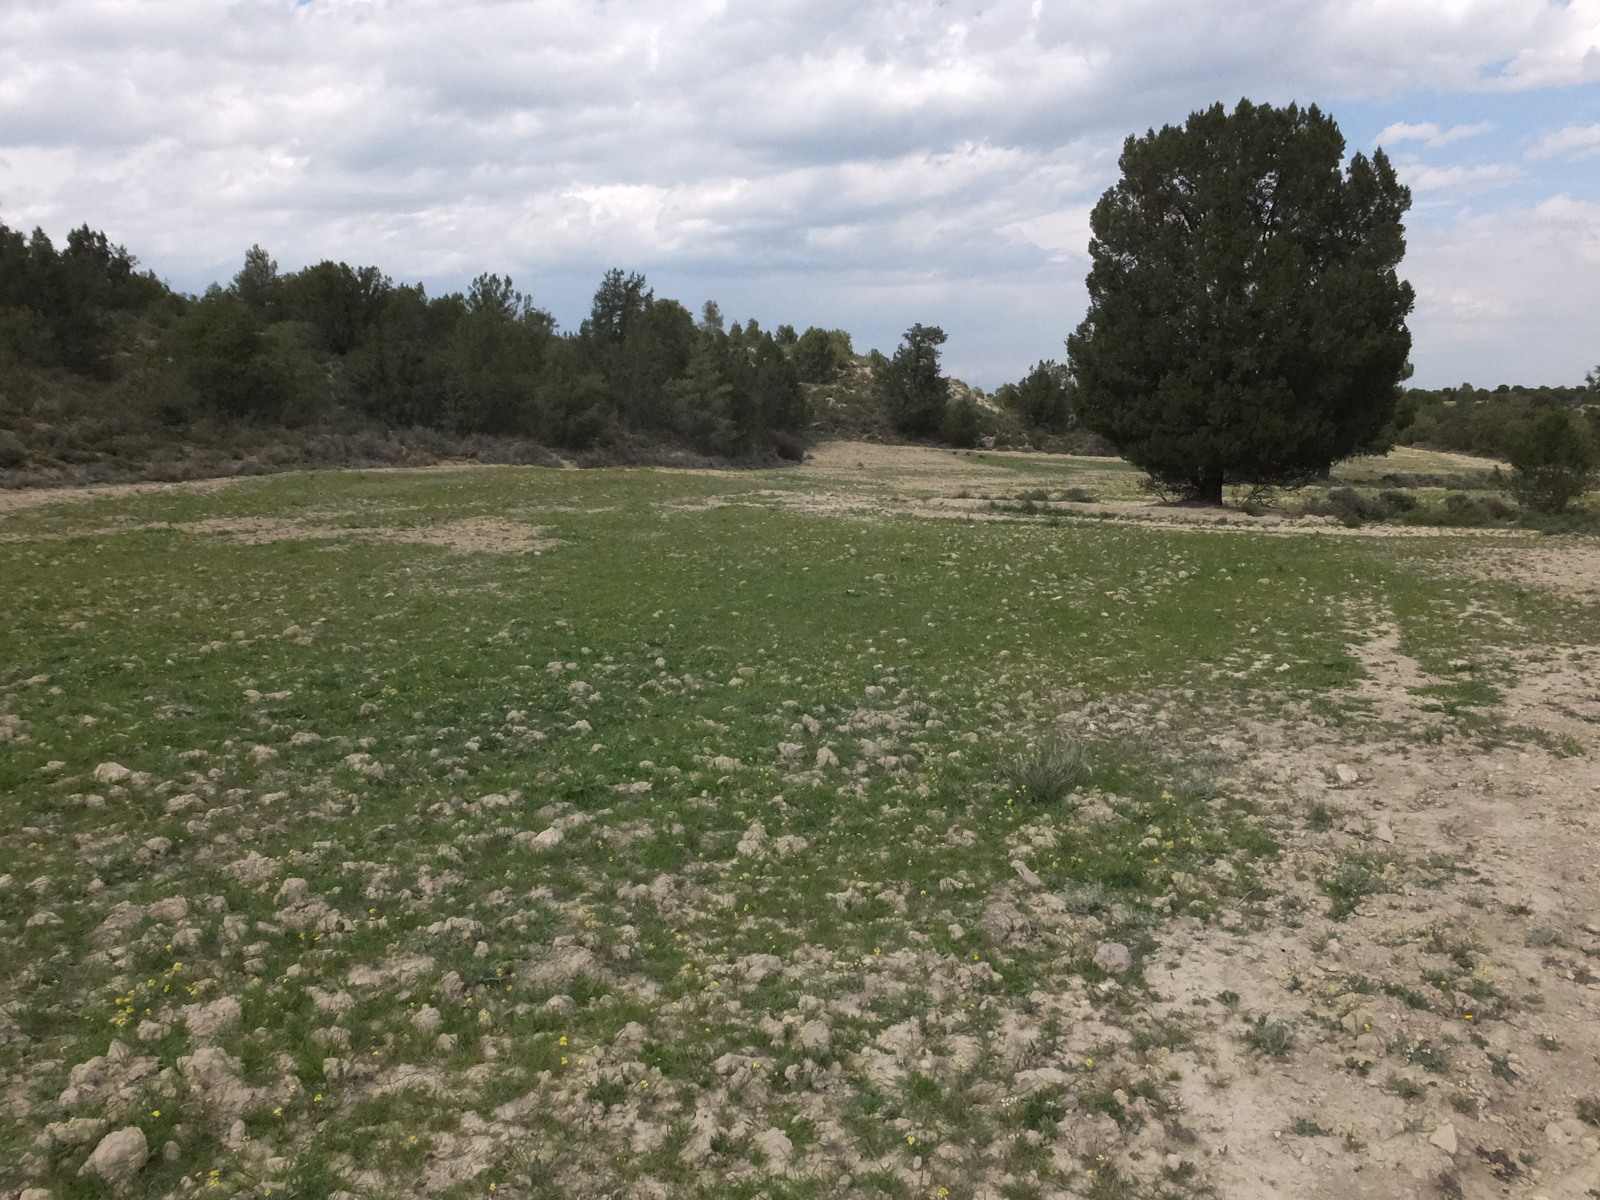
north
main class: Grassland
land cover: Spontaneously vegetated surfaces
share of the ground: 50 - 75 %
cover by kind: herbaceous plants 50 %, unconsolidated bare surface 50 %
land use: Agriculture (excluding fallow land and kitchen gardens)
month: April
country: ES
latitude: 41.7177
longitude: -0.3920
